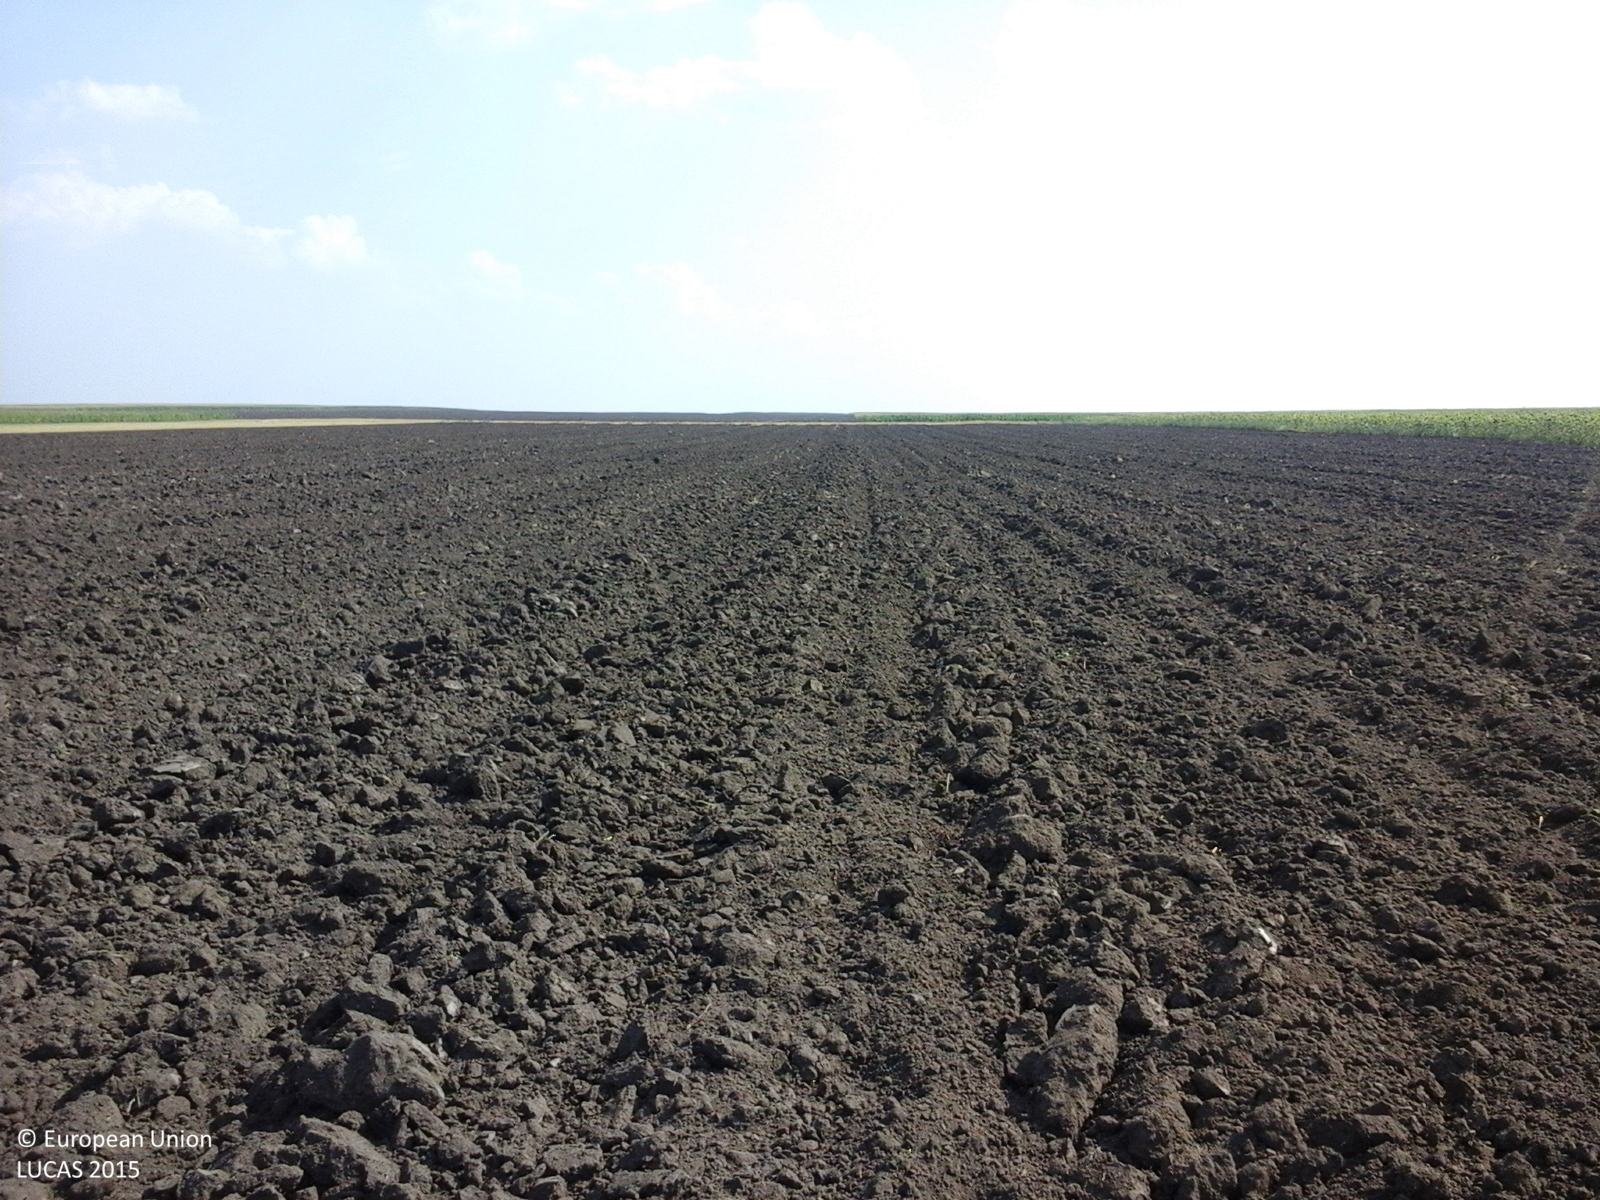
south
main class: Cropland
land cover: Common wheat
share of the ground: < 10 %
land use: Agriculture (excluding fallow land and kitchen gardens)
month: July
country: RO
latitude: 45.9947
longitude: 27.5246
